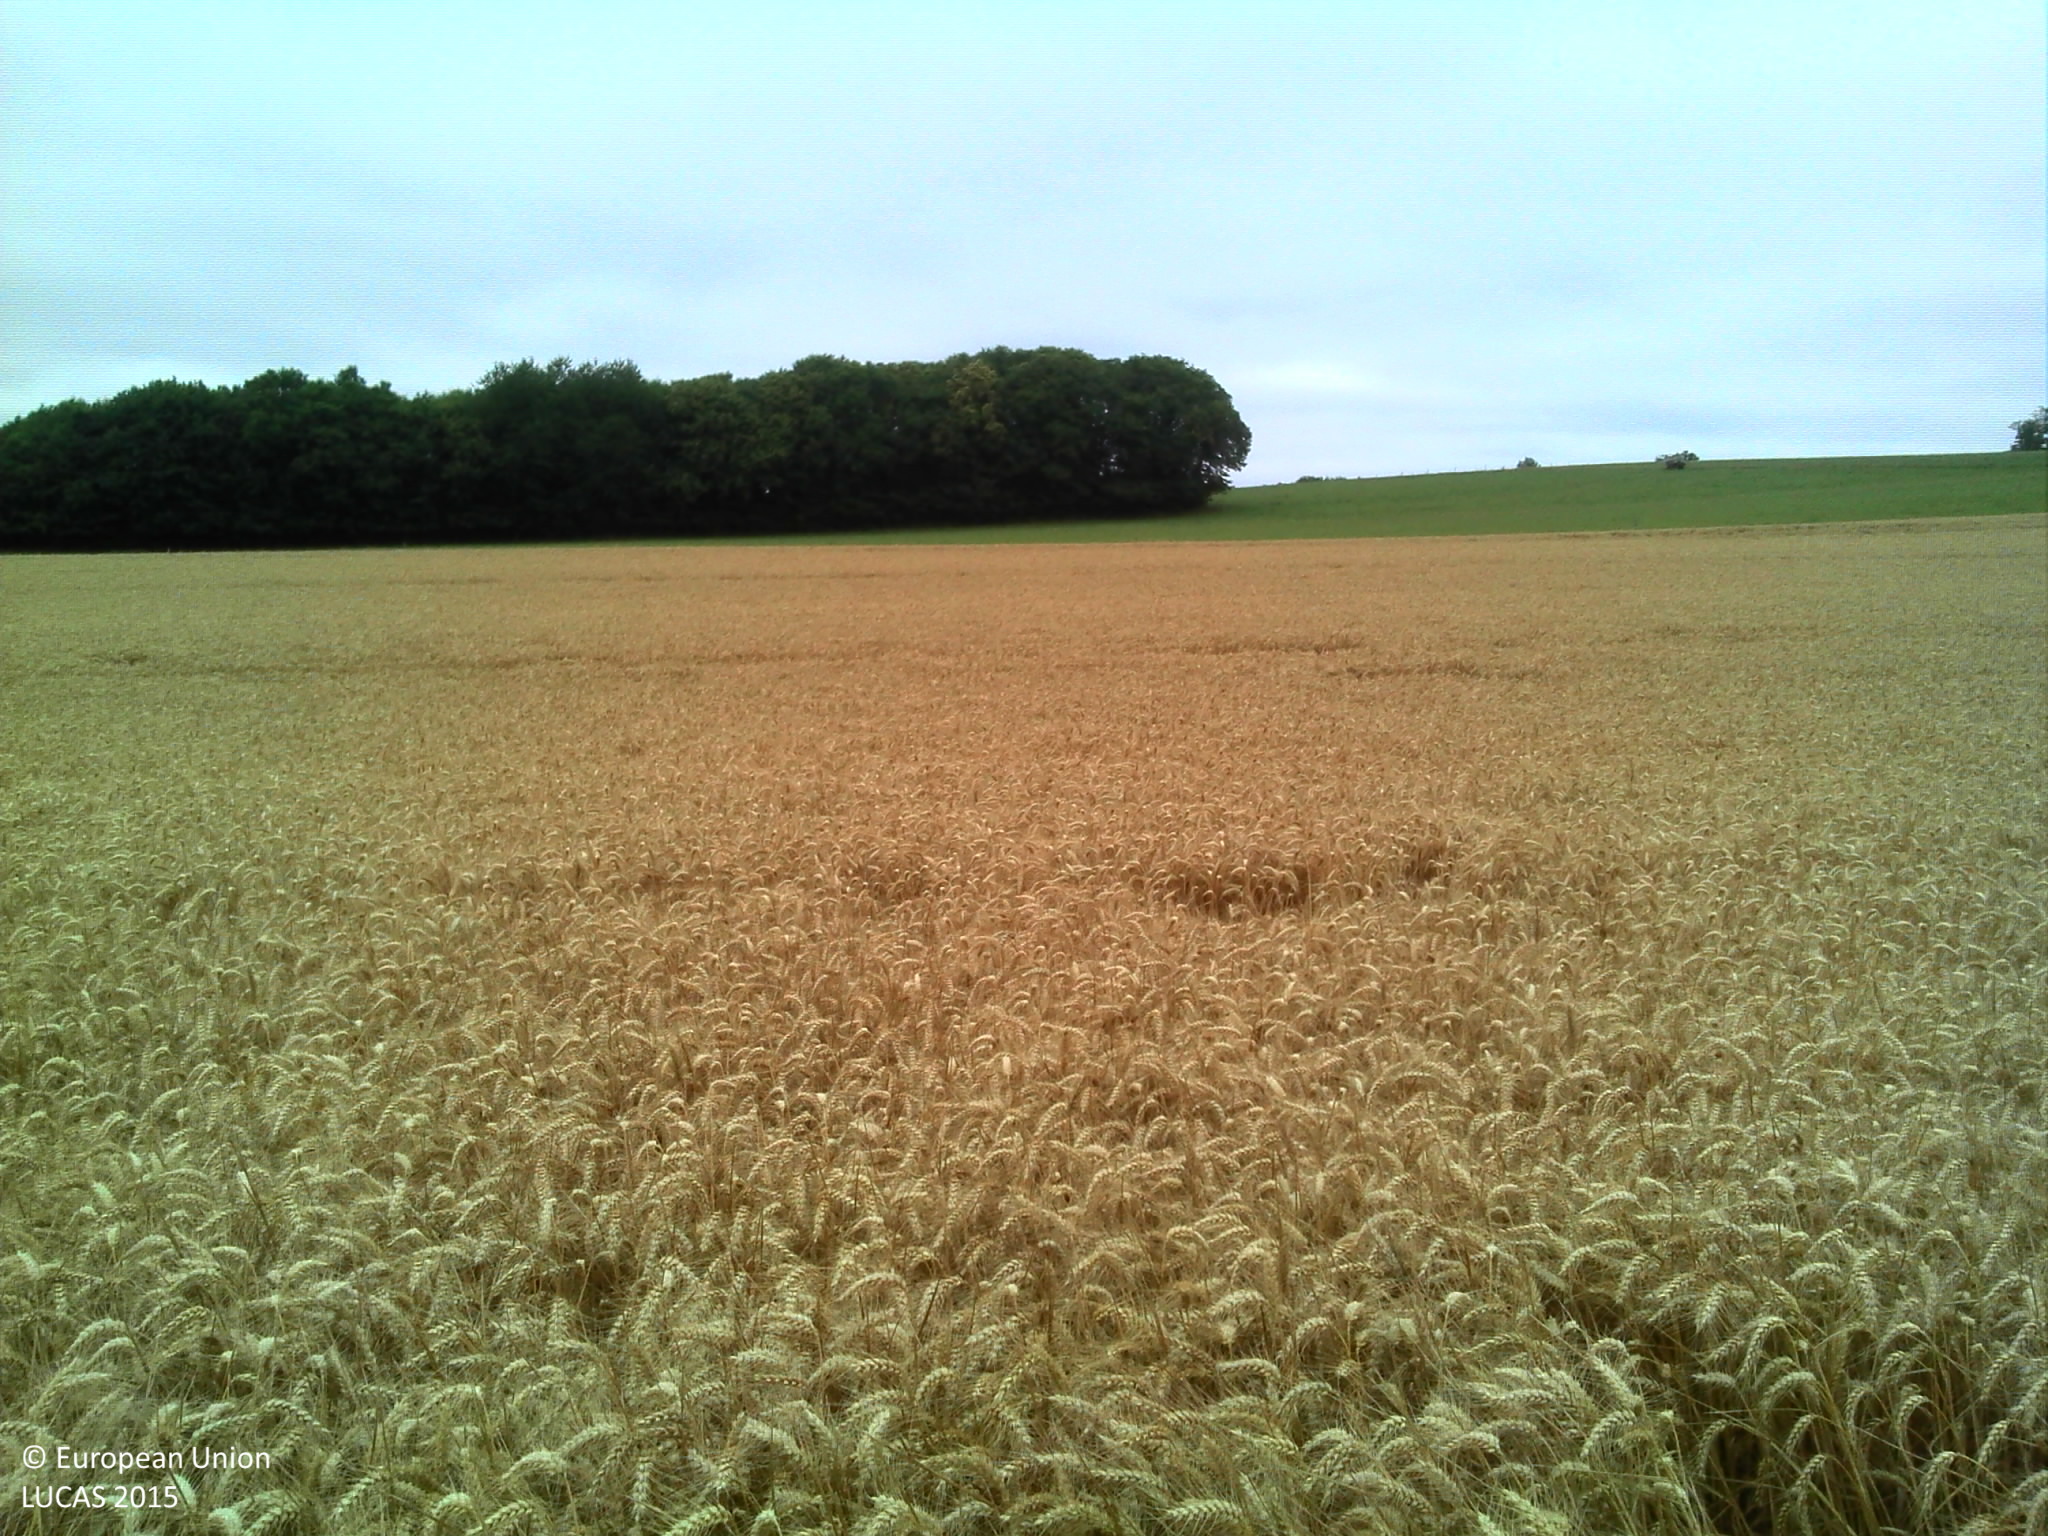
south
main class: Cropland
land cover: Common wheat
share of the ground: > 75 %
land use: Agriculture (excluding fallow land and kitchen gardens)
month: July
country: FR
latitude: 47.6302
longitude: -1.9064
